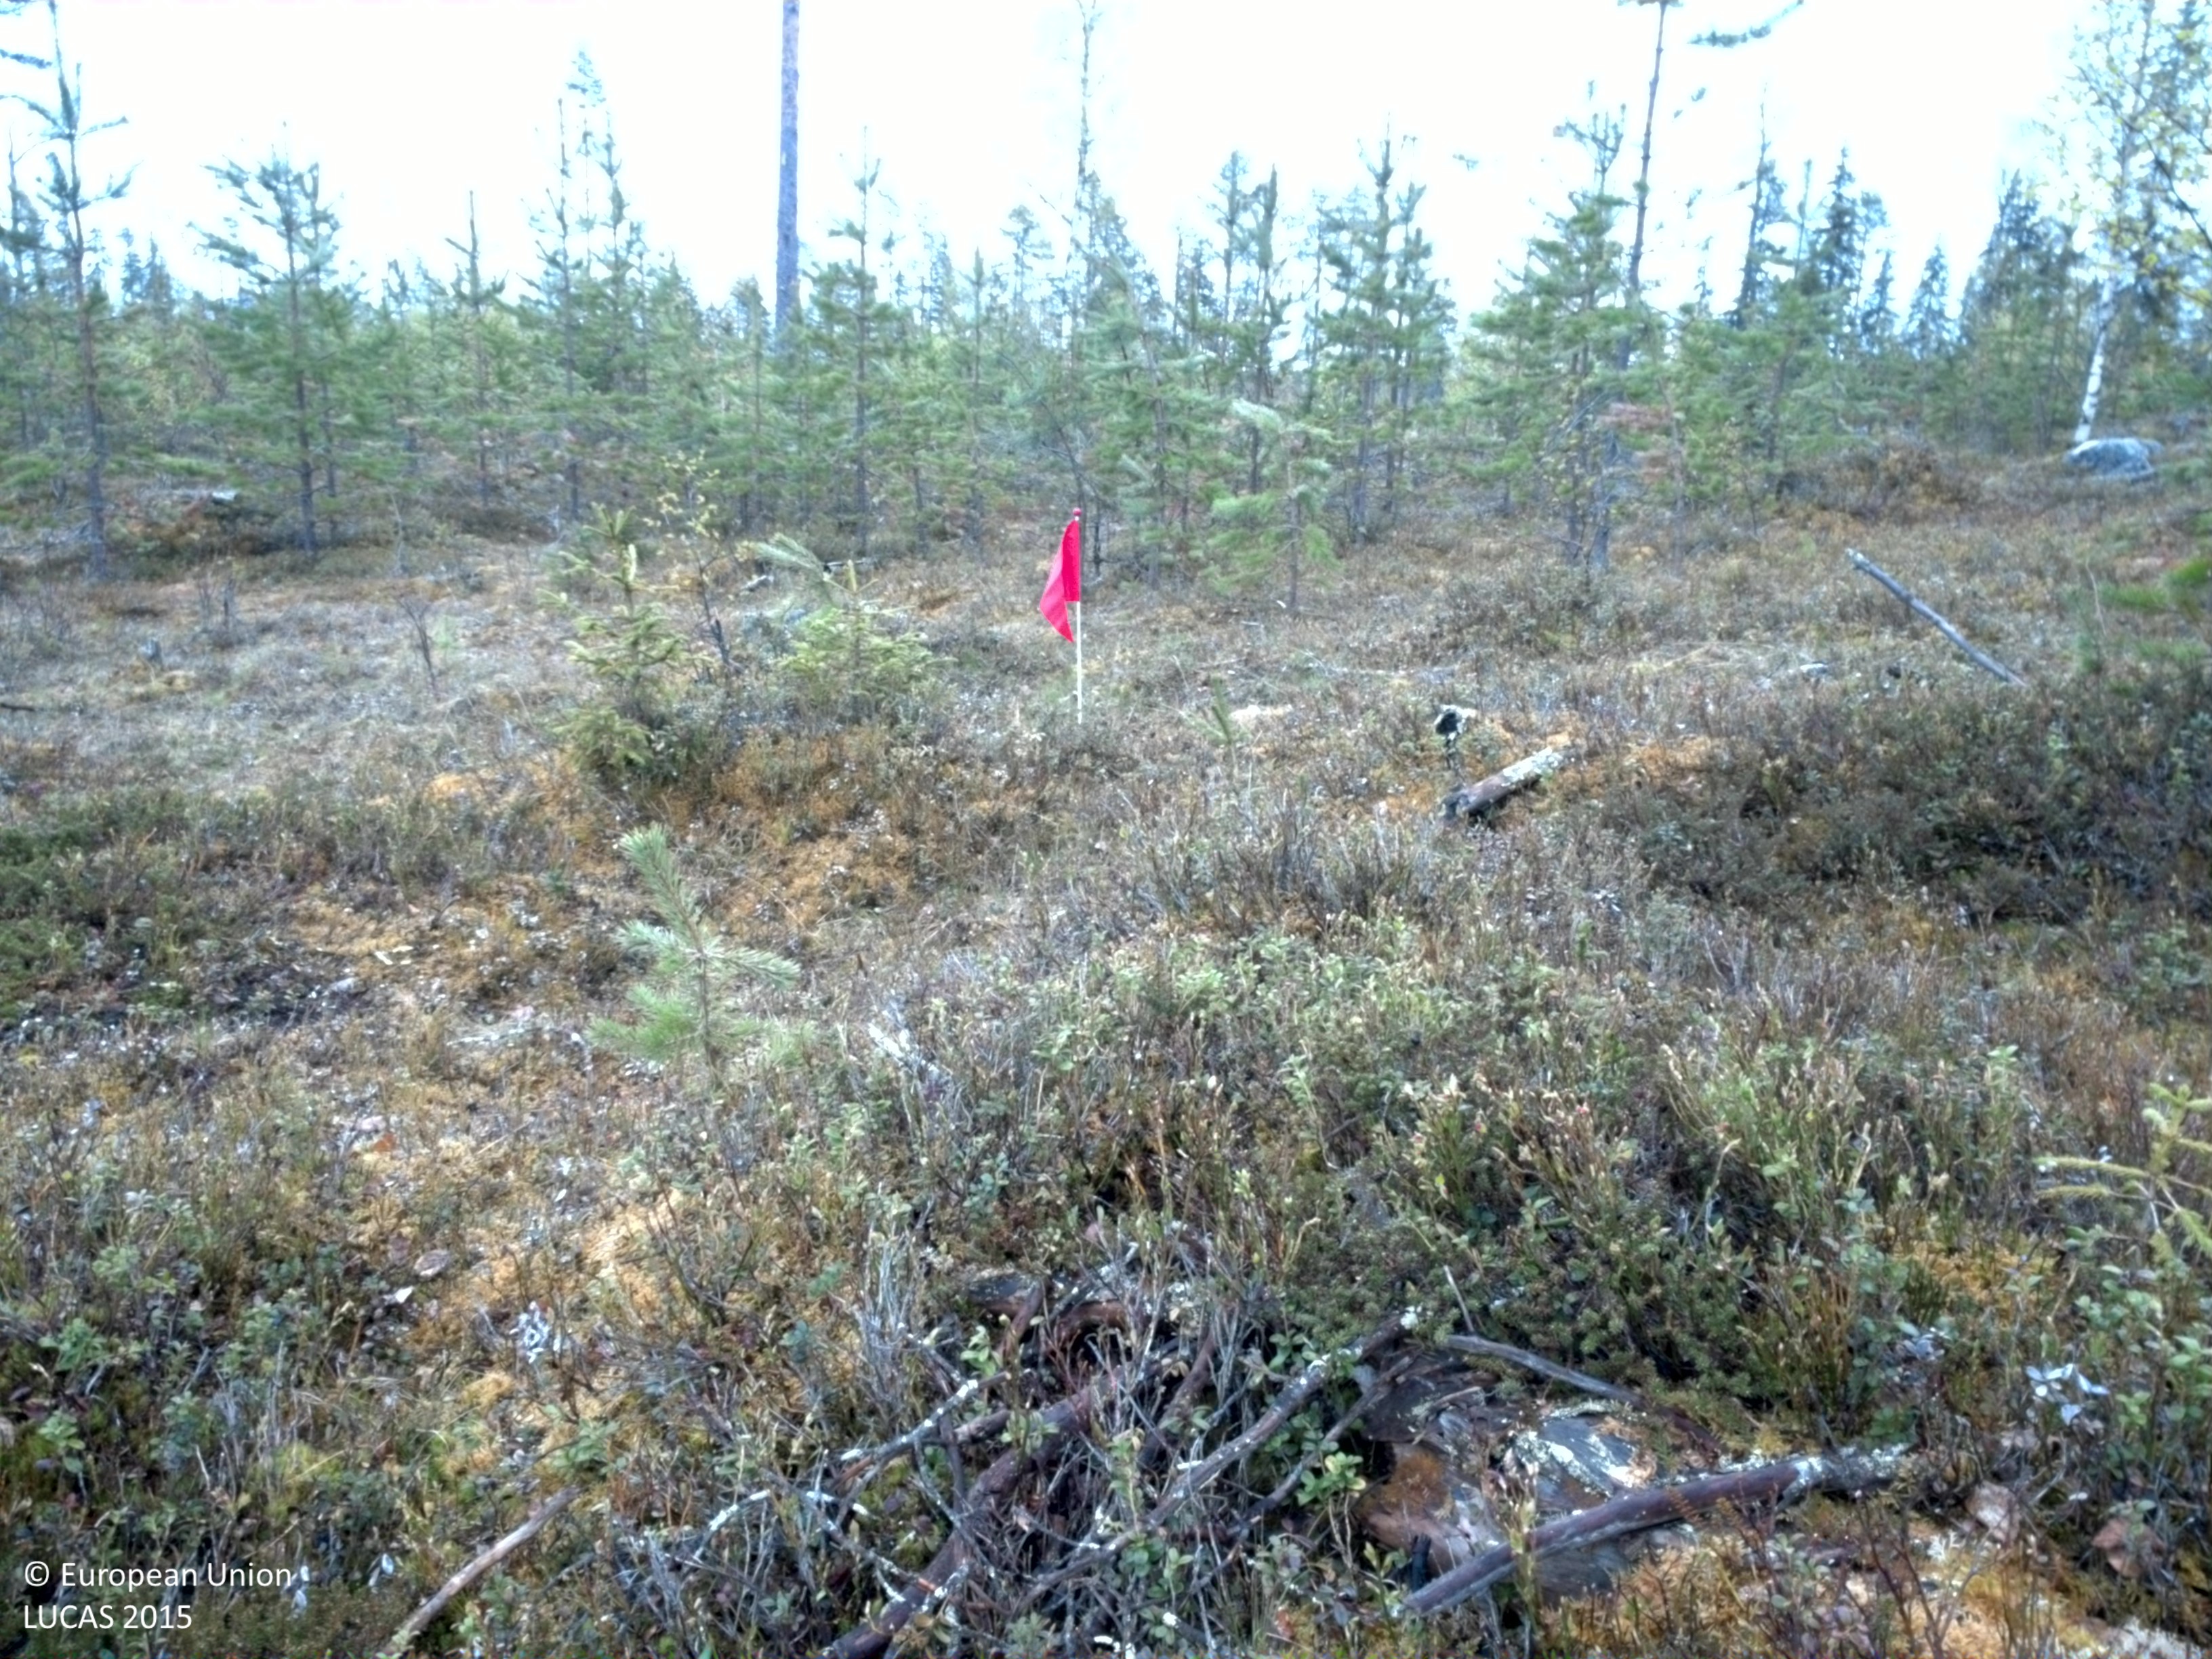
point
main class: Woodland
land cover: Pine dominated coniferous woodland
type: boreal forest
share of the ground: 25 - 50 %
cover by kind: shrubs 45 %, coniferous forest trees 40 %, broadleaved forest trees 5 %, herbaceous plants 5 %, lichens and mosses 5 %
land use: Forestry
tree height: < 5 m
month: June
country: SE
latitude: 65.9396
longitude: 23.1984
